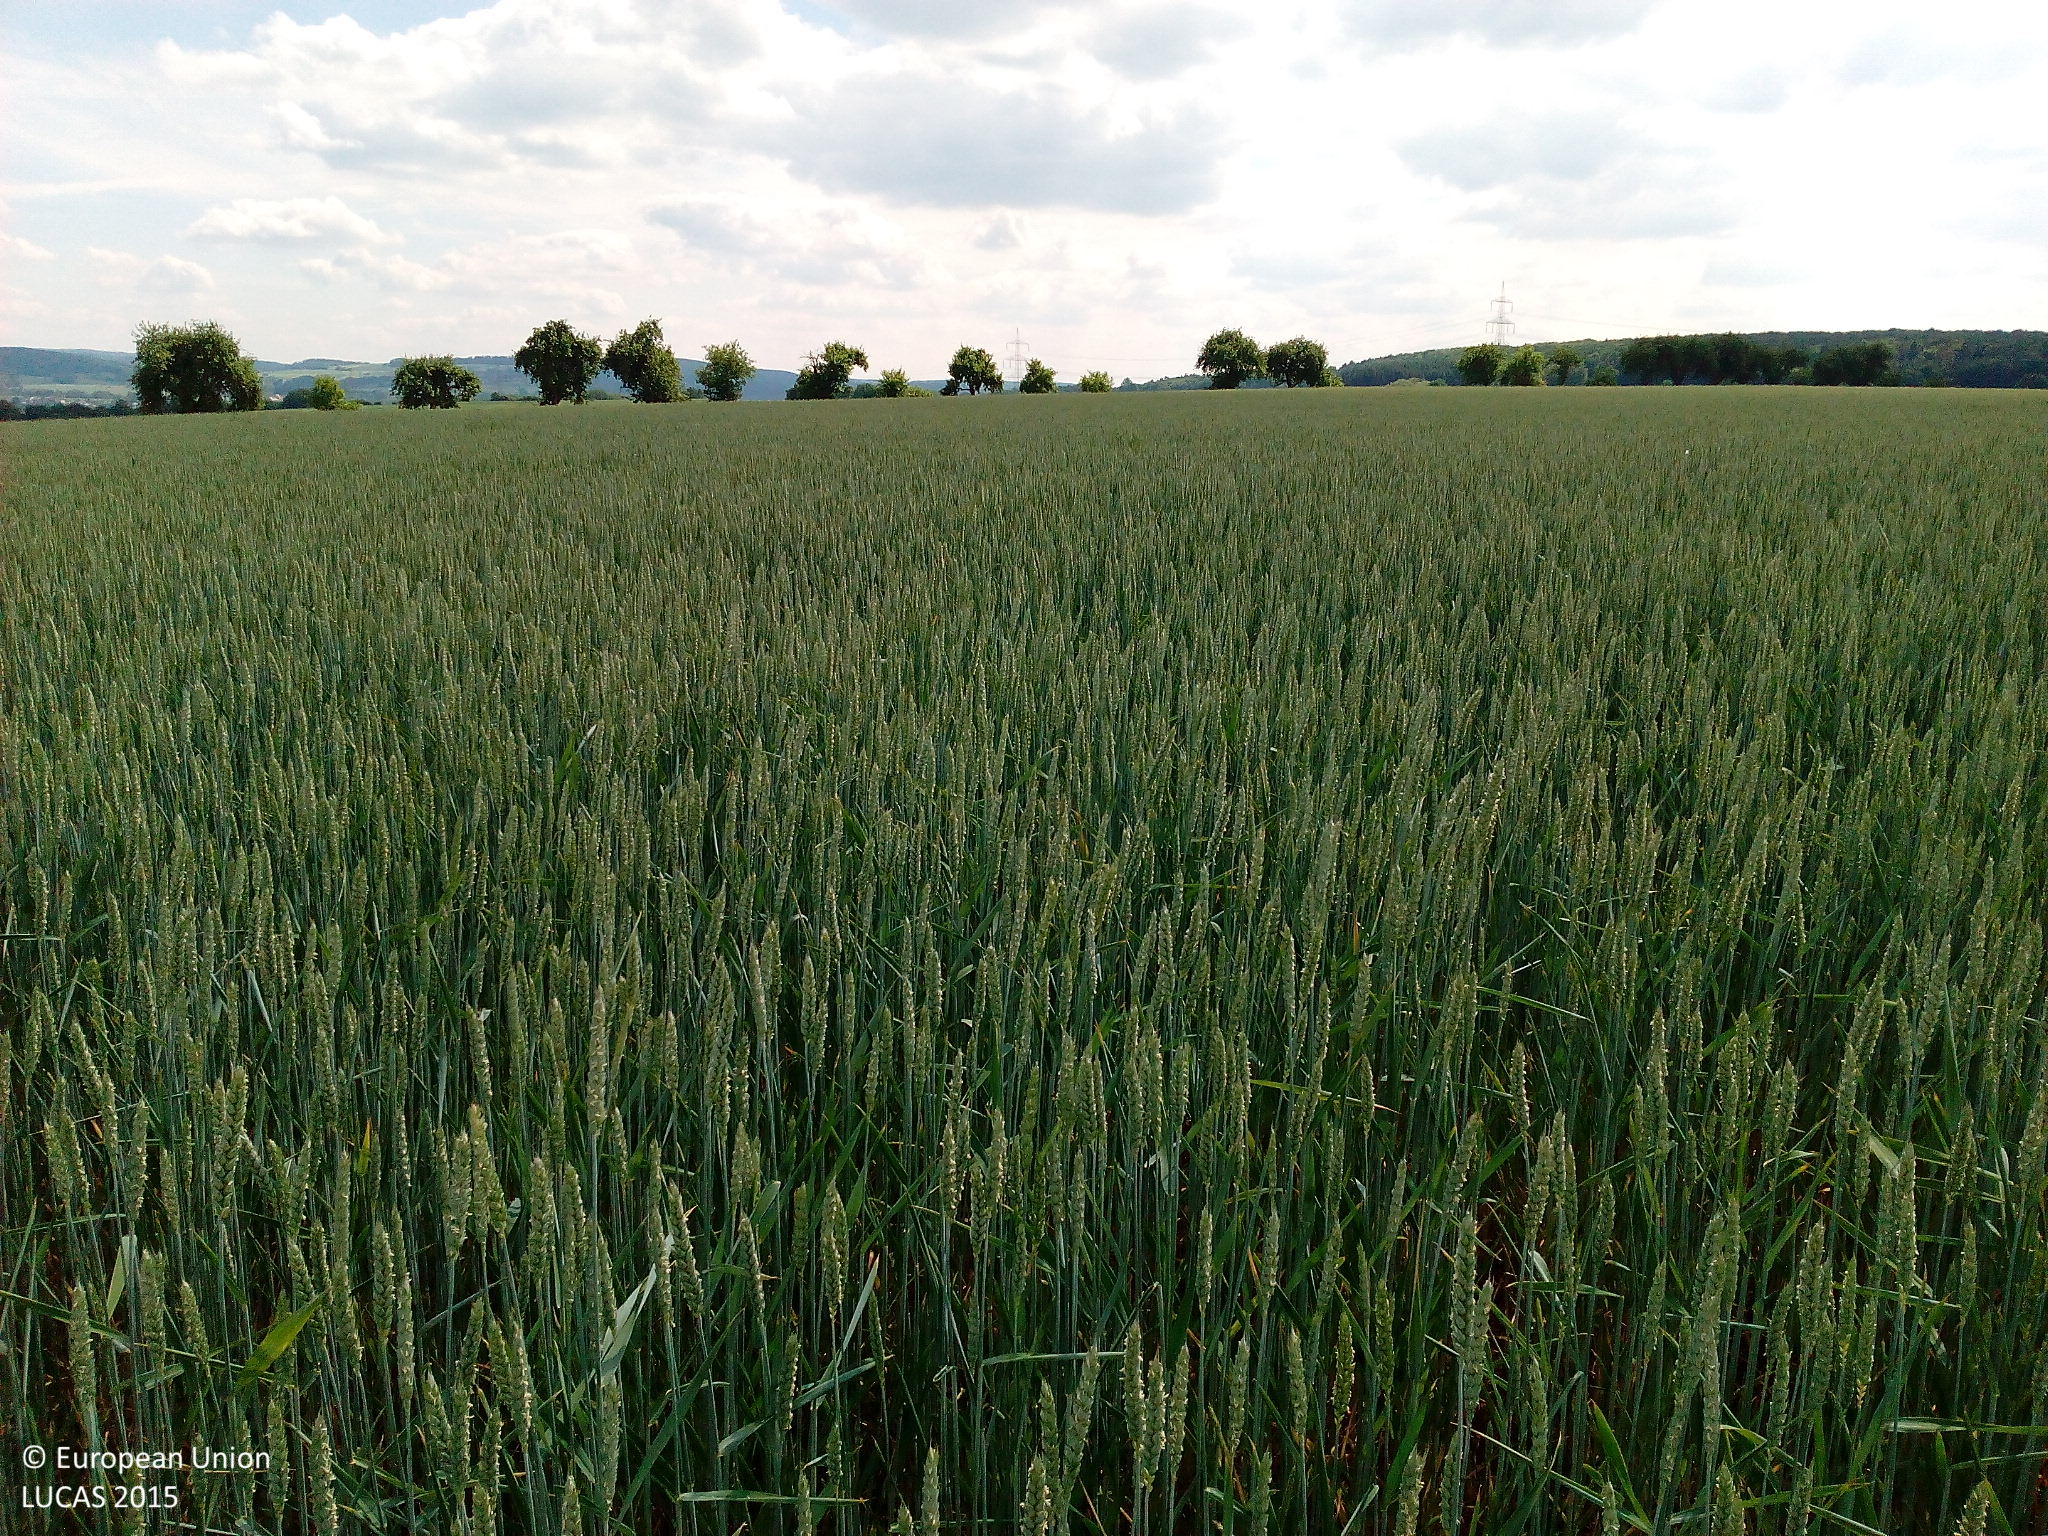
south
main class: Cropland
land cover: Common wheat
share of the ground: > 75 %
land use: Agriculture (excluding fallow land and kitchen gardens)
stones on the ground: < 10 %
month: June
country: DE
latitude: 51.0275
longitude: 9.3586
